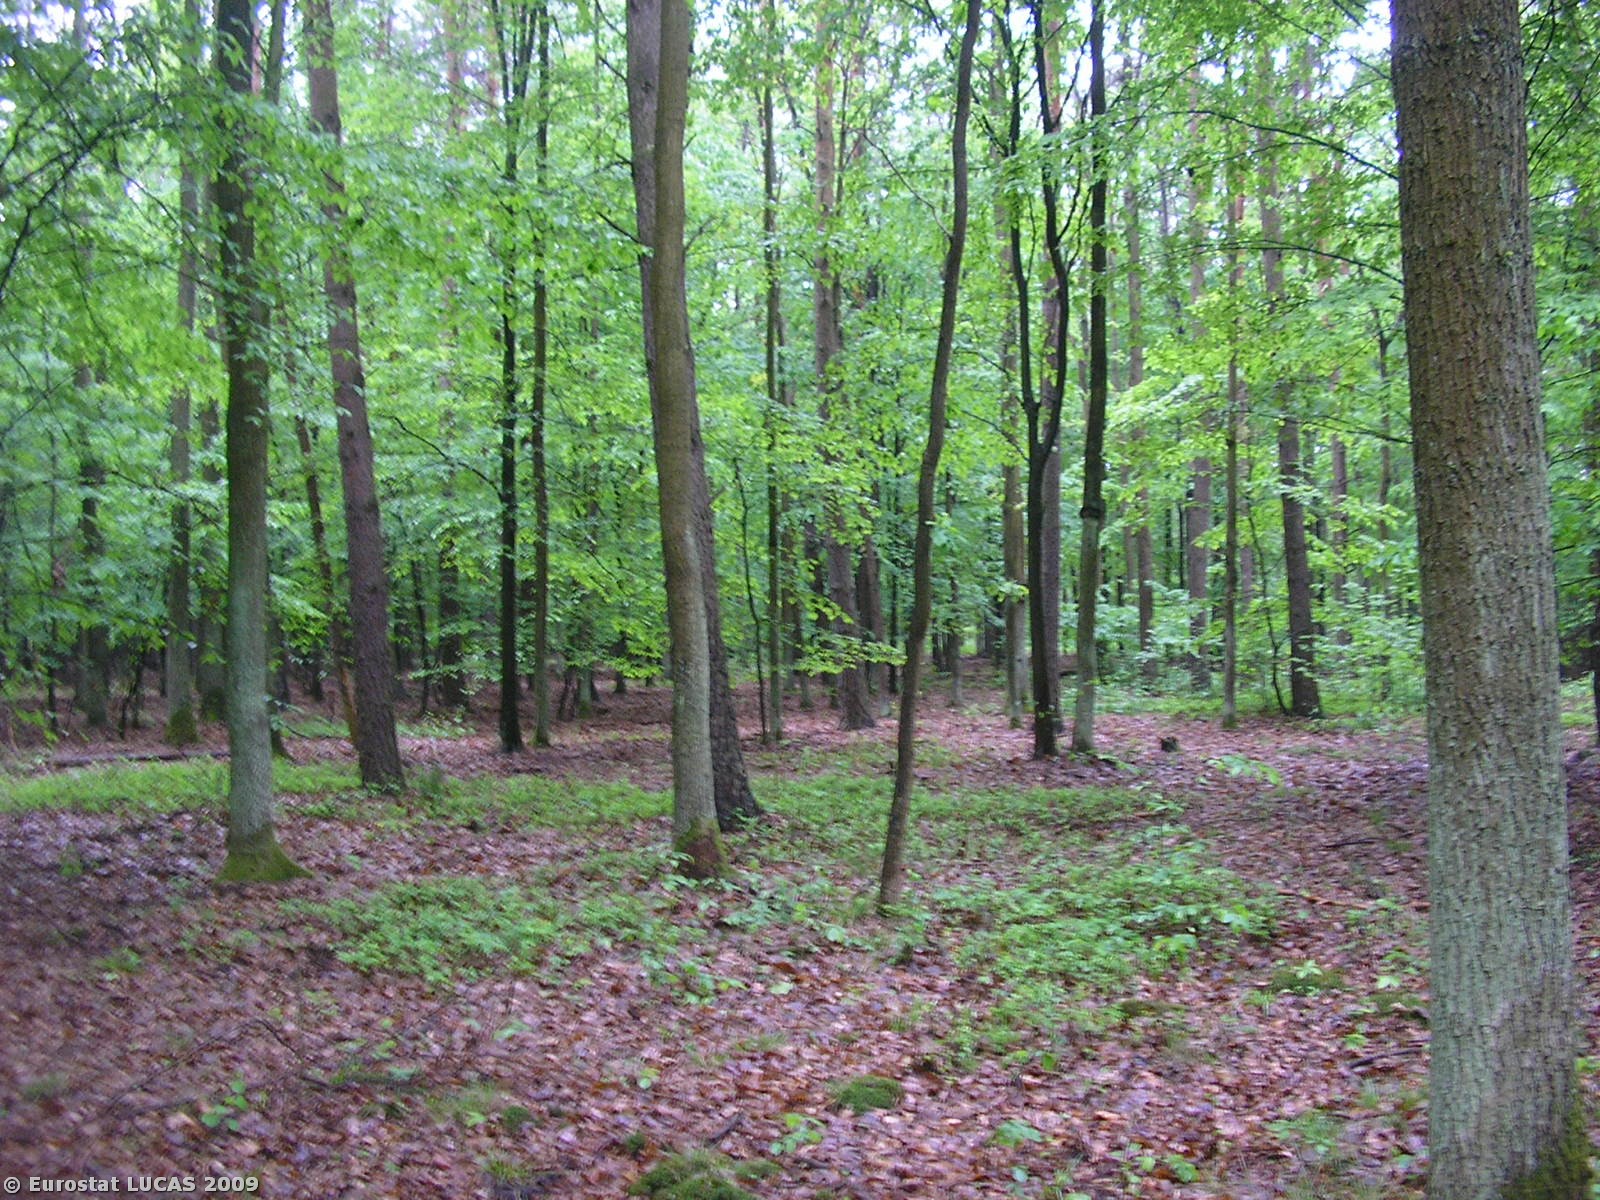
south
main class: Woodland
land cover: Broadleaved woodland
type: mesophytic deciduous forest
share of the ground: > 75 %
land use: Forestry
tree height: > 5 m
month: May
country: PL
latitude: 51.5936
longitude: 19.9785
